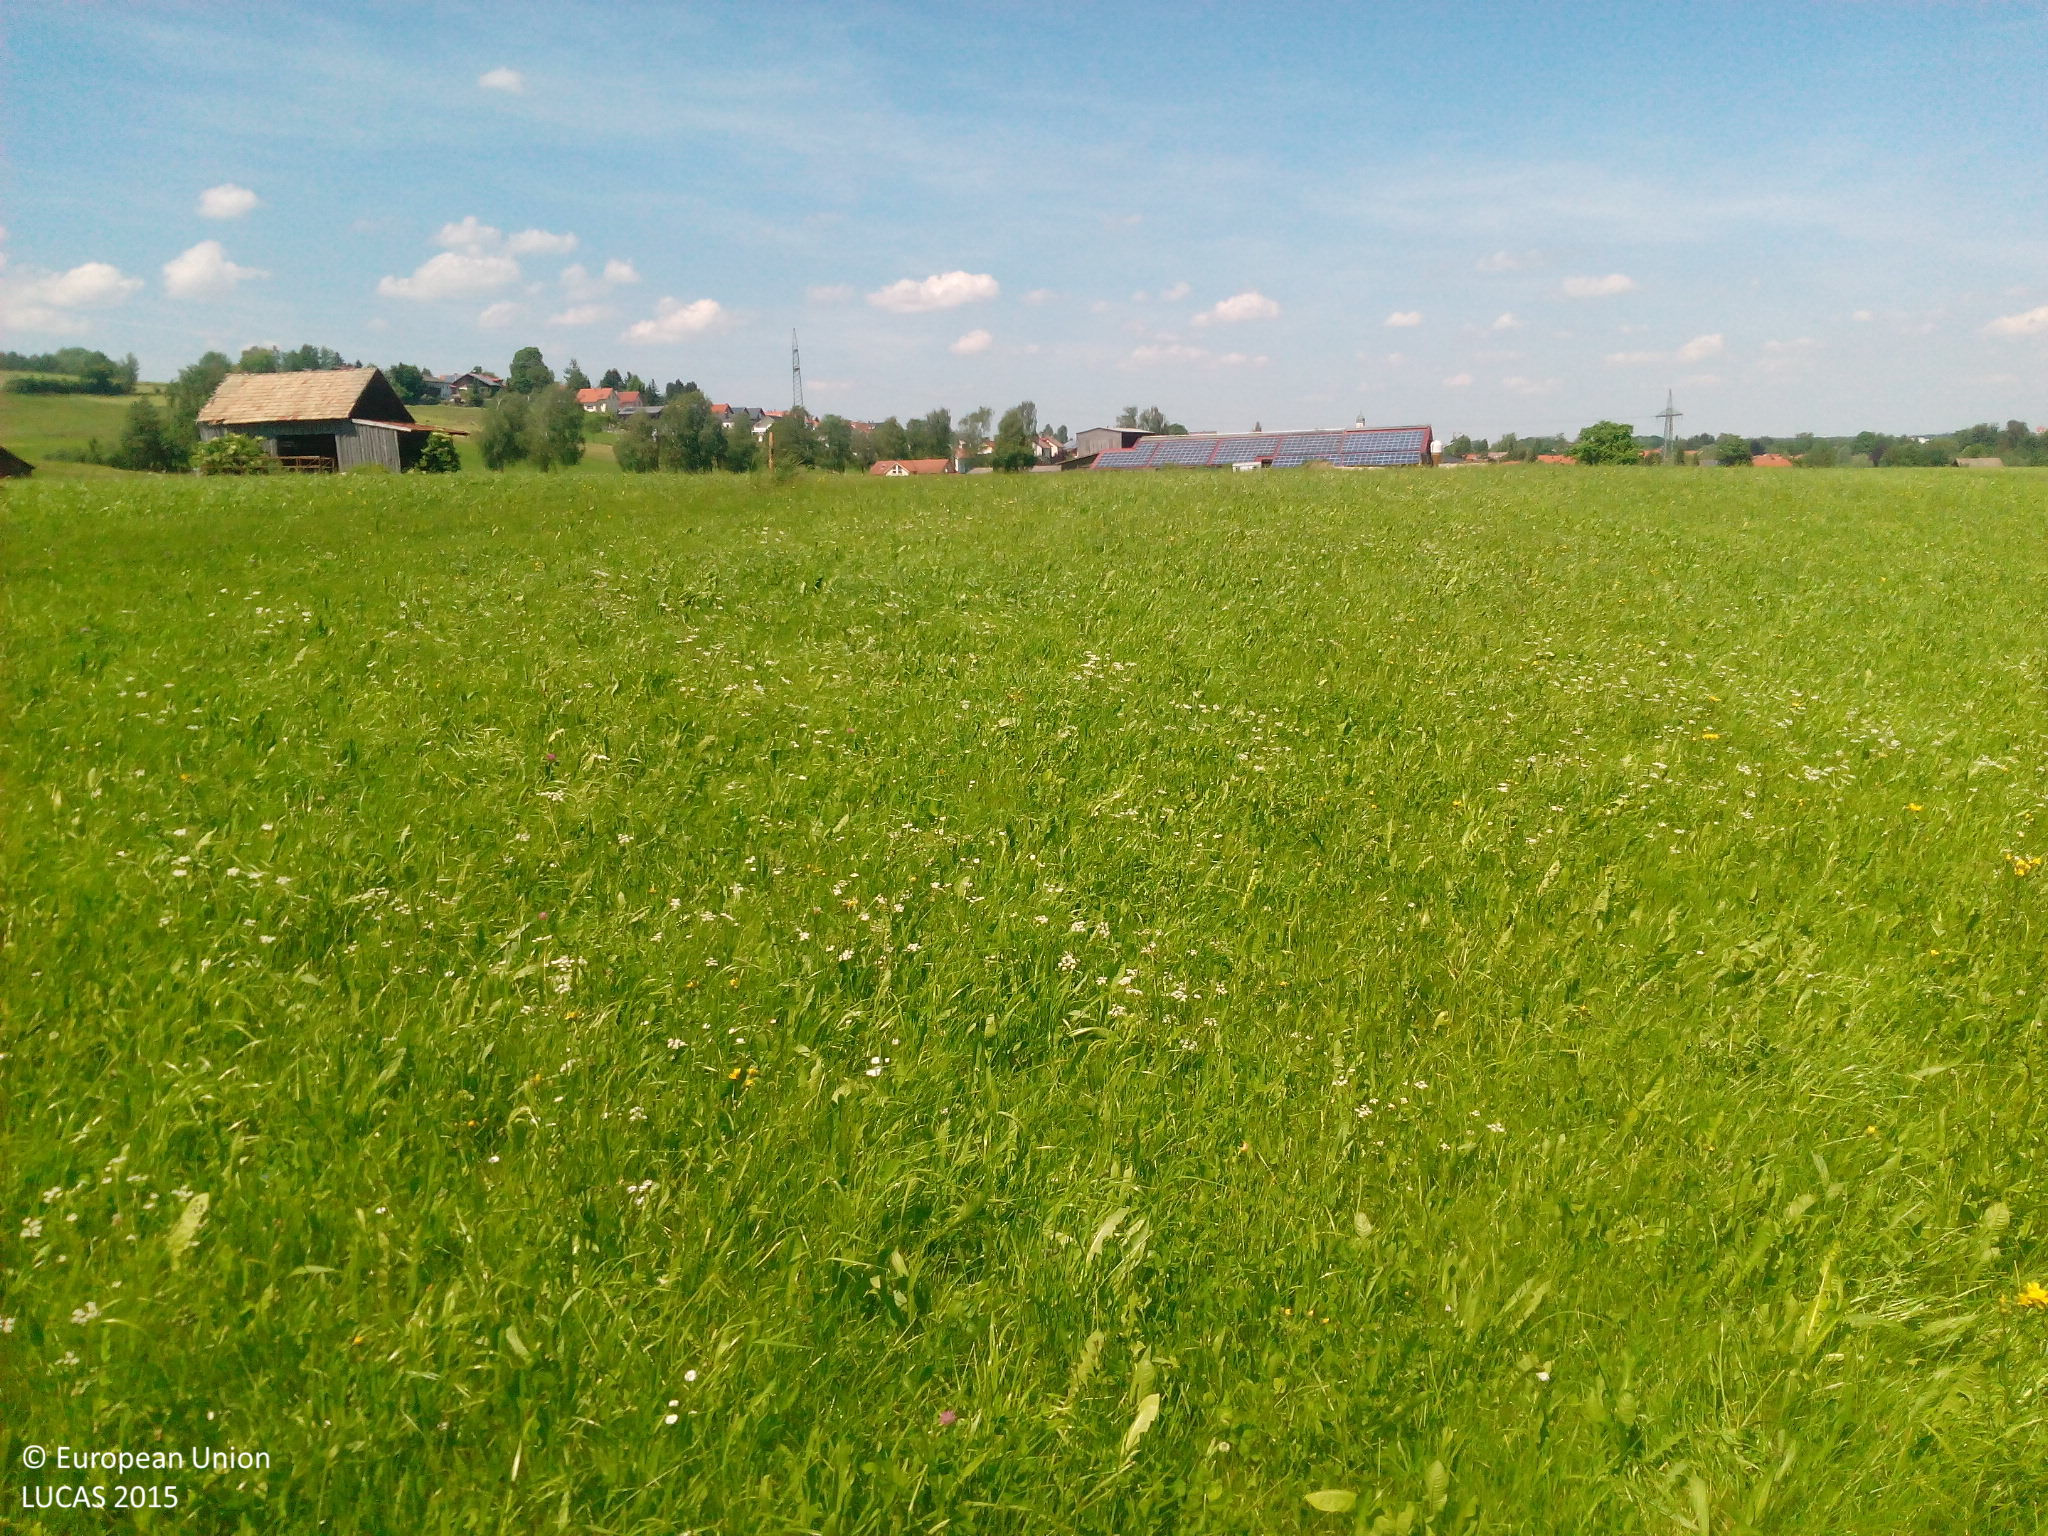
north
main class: Grassland
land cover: Grassland without tree/shrub cover
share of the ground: > 75 %
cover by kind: herbaceous plants 100 %
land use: Agriculture (excluding fallow land and kitchen gardens)
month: June
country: DE
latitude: 47.8620
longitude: 10.6011
